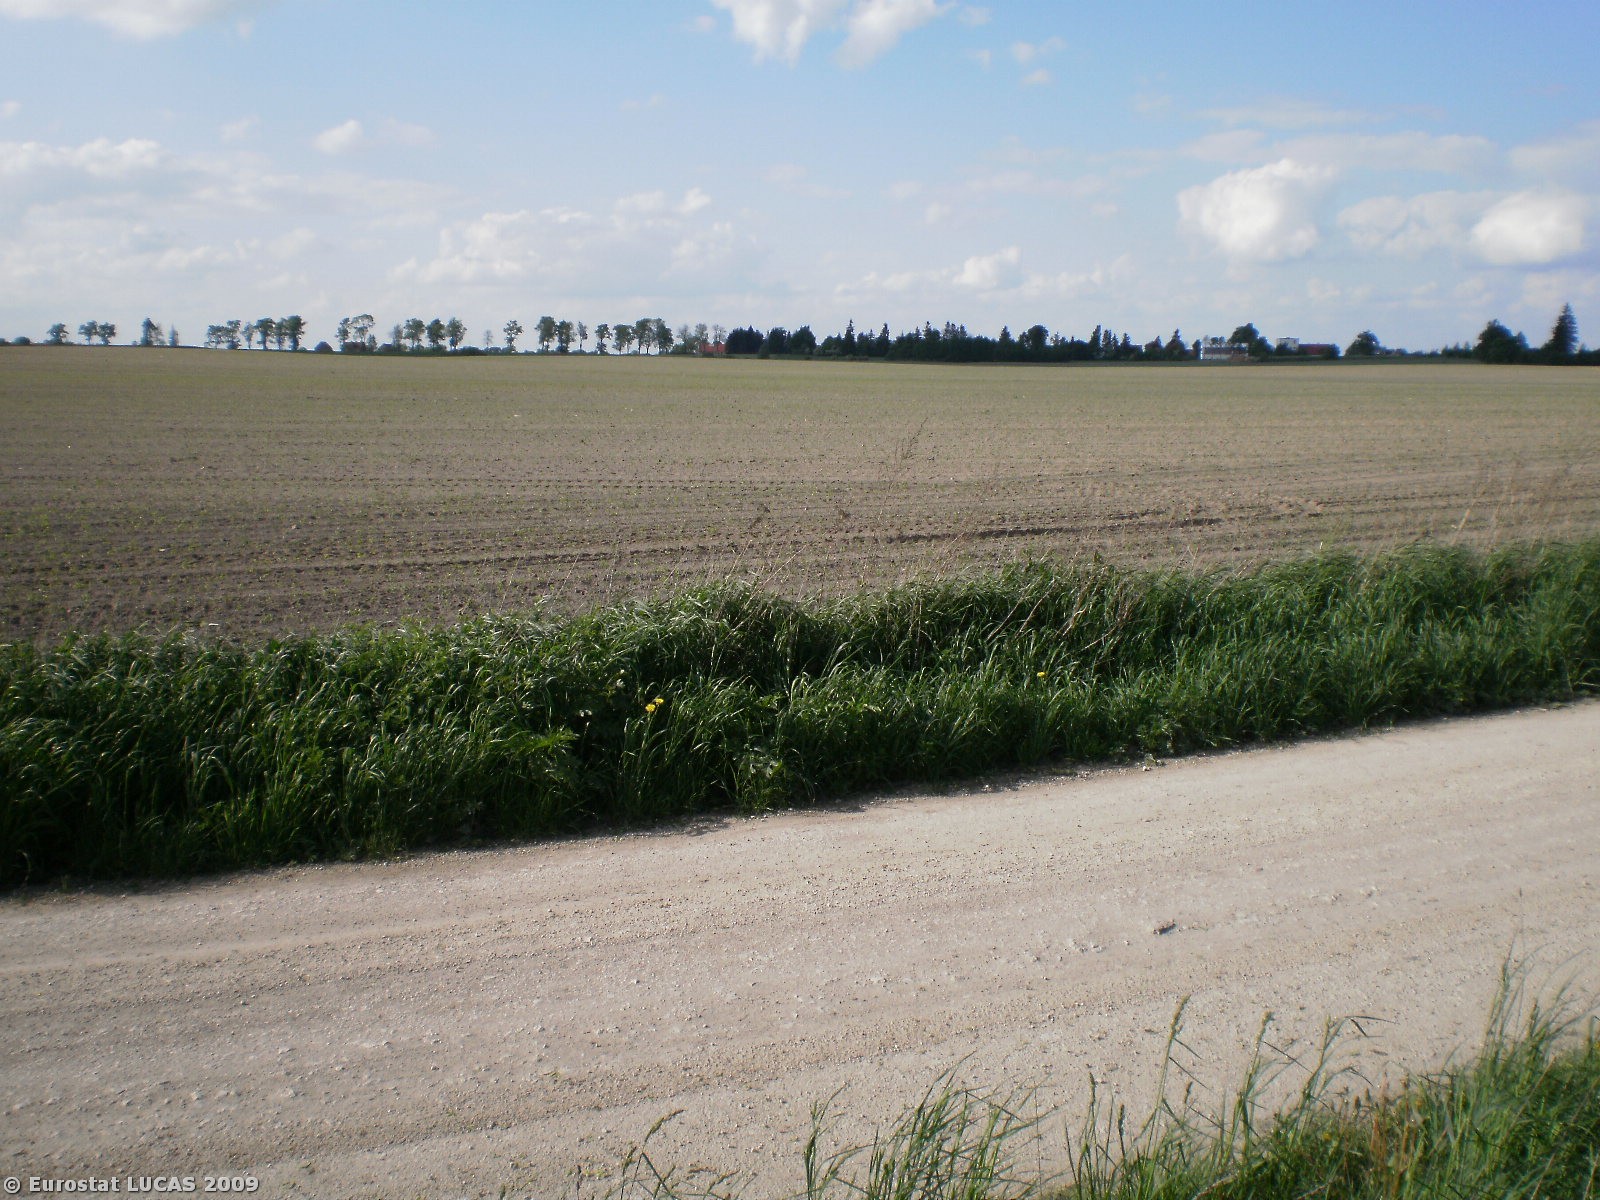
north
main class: Cropland
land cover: Rape and turnip rape
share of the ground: > 75 %
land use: Agriculture (excluding fallow land and kitchen gardens)
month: May
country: PL
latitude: 53.4649
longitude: 17.6799
